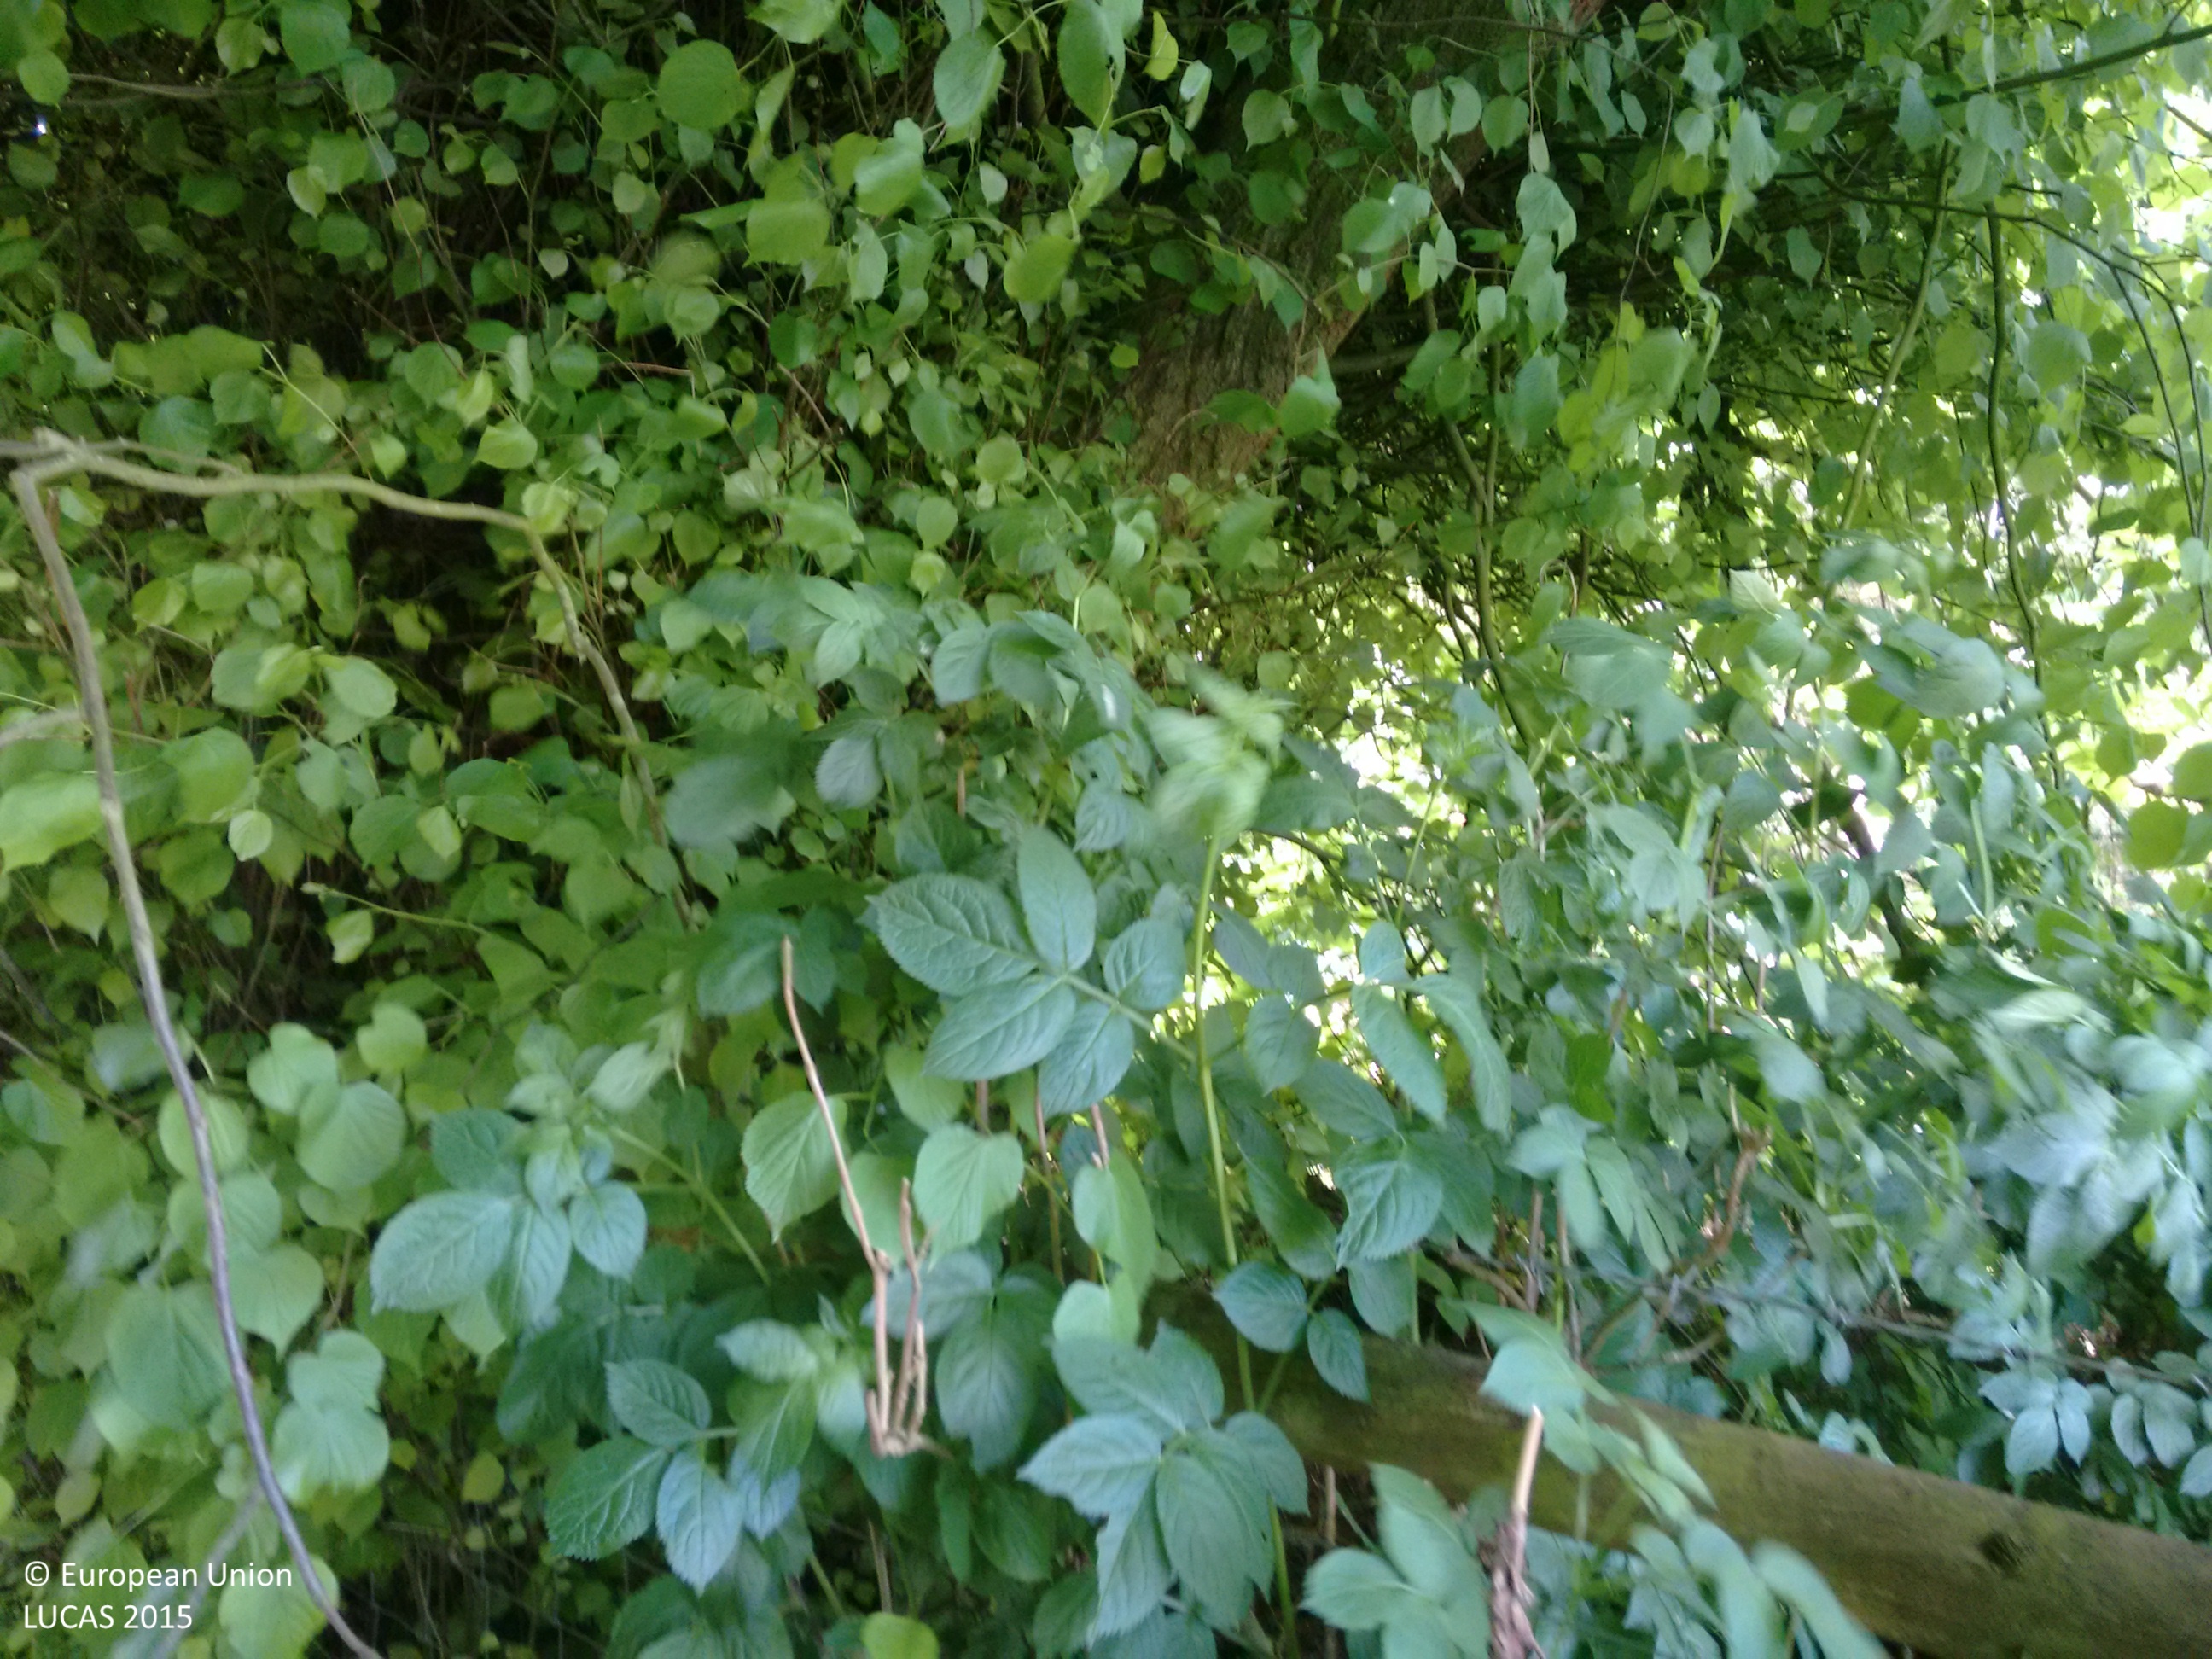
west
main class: Grassland
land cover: Grassland without tree/shrub cover
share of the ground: > 75 %
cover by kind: herbaceous plants 100 %
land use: Agriculture (excluding fallow land and kitchen gardens)
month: May
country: GB
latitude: 51.2340
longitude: 1.1699
